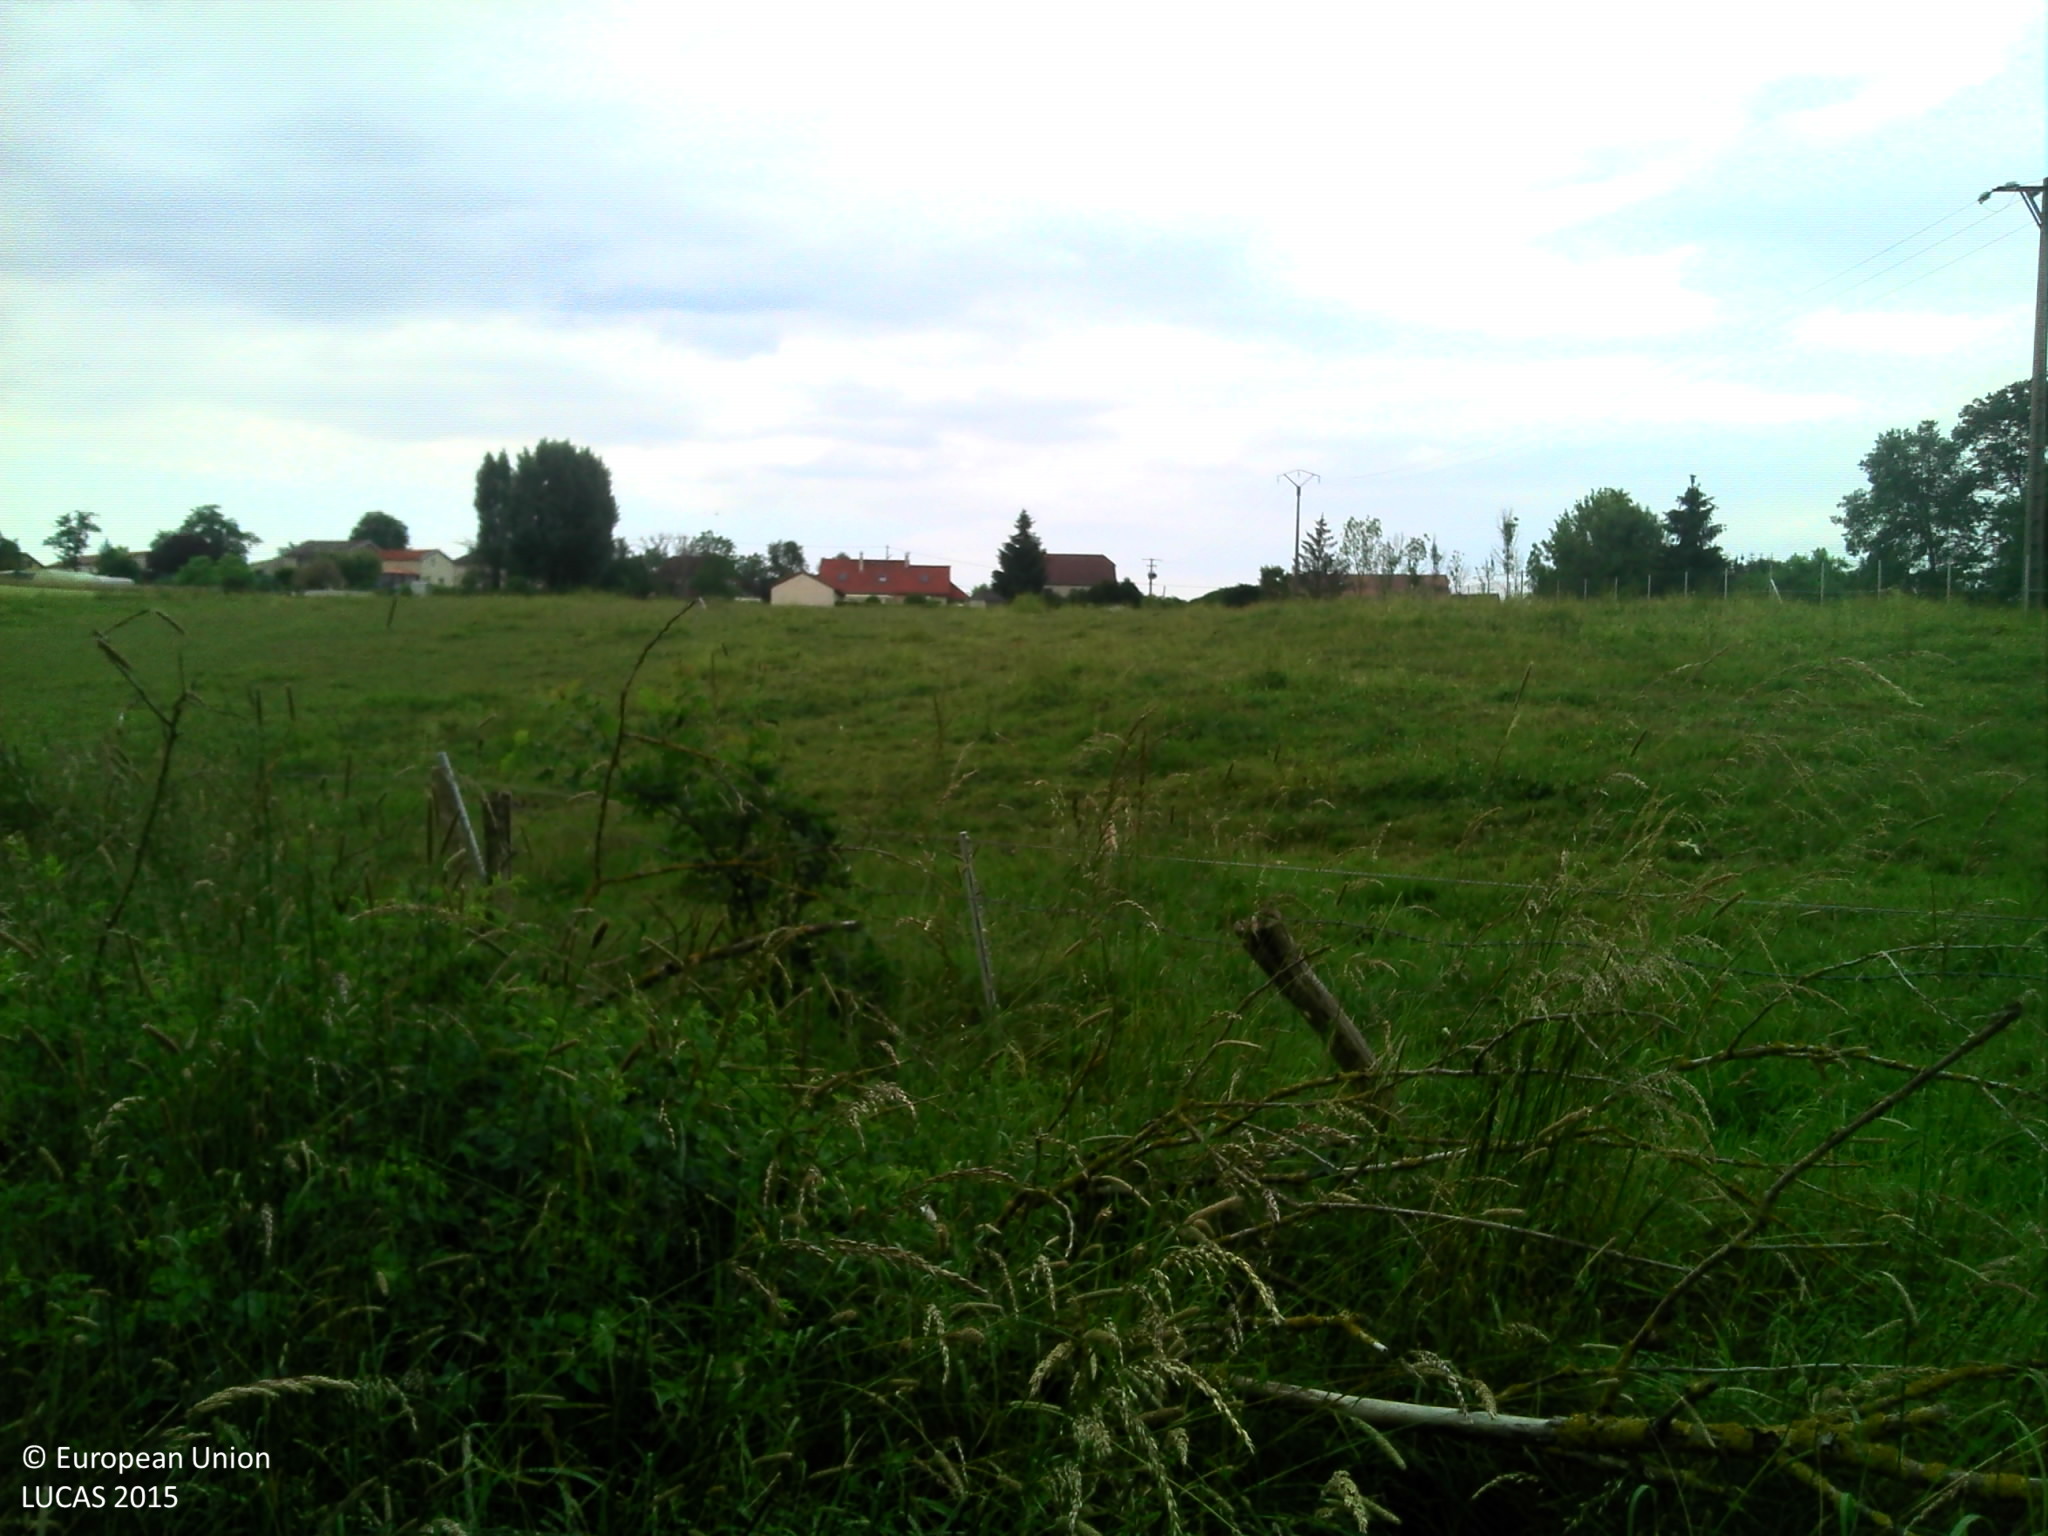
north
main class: Grassland
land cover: Grassland with sparse tree/shrub cover
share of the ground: > 75 %
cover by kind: herbaceous plants 95 %, broadleaved forest trees 5 %
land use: Agriculture (excluding fallow land and kitchen gardens)
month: June
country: FR
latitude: 48.6876
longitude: 5.0129
